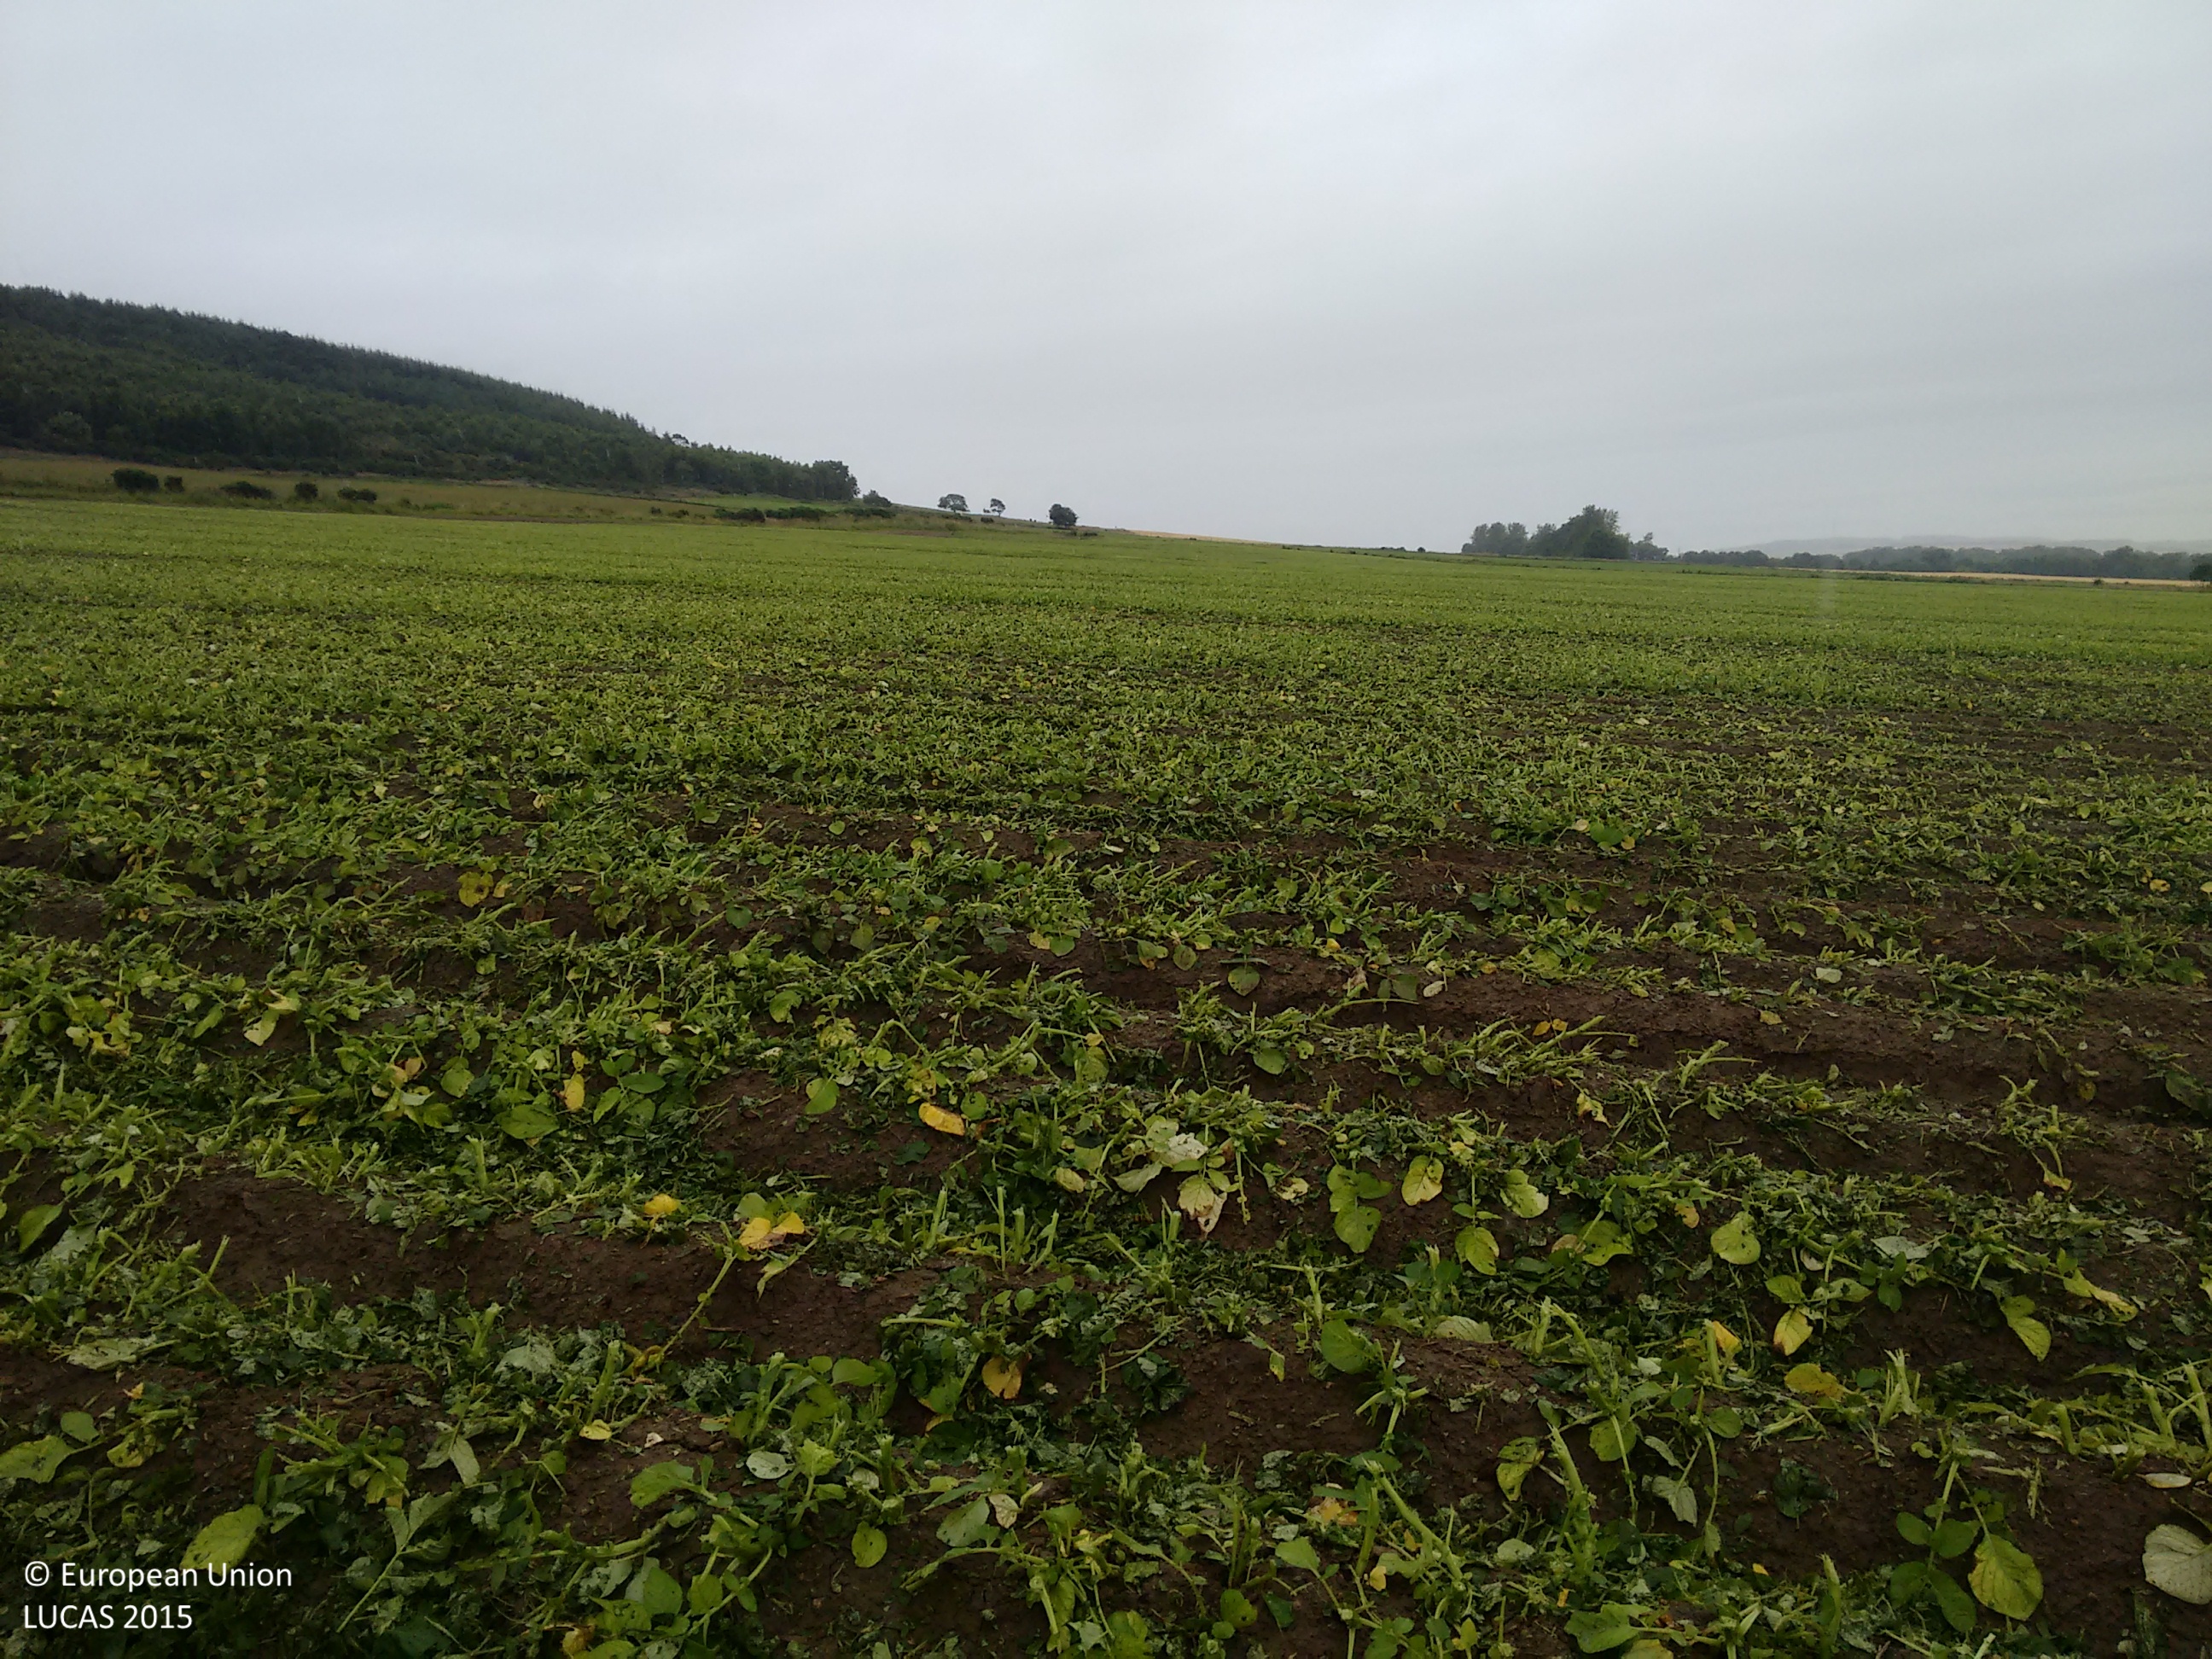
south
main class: Cropland
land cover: Potatoes
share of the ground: 10 - 25 %
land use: Agriculture (excluding fallow land and kitchen gardens)
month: August
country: GB
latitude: 57.7199
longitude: -3.9965
